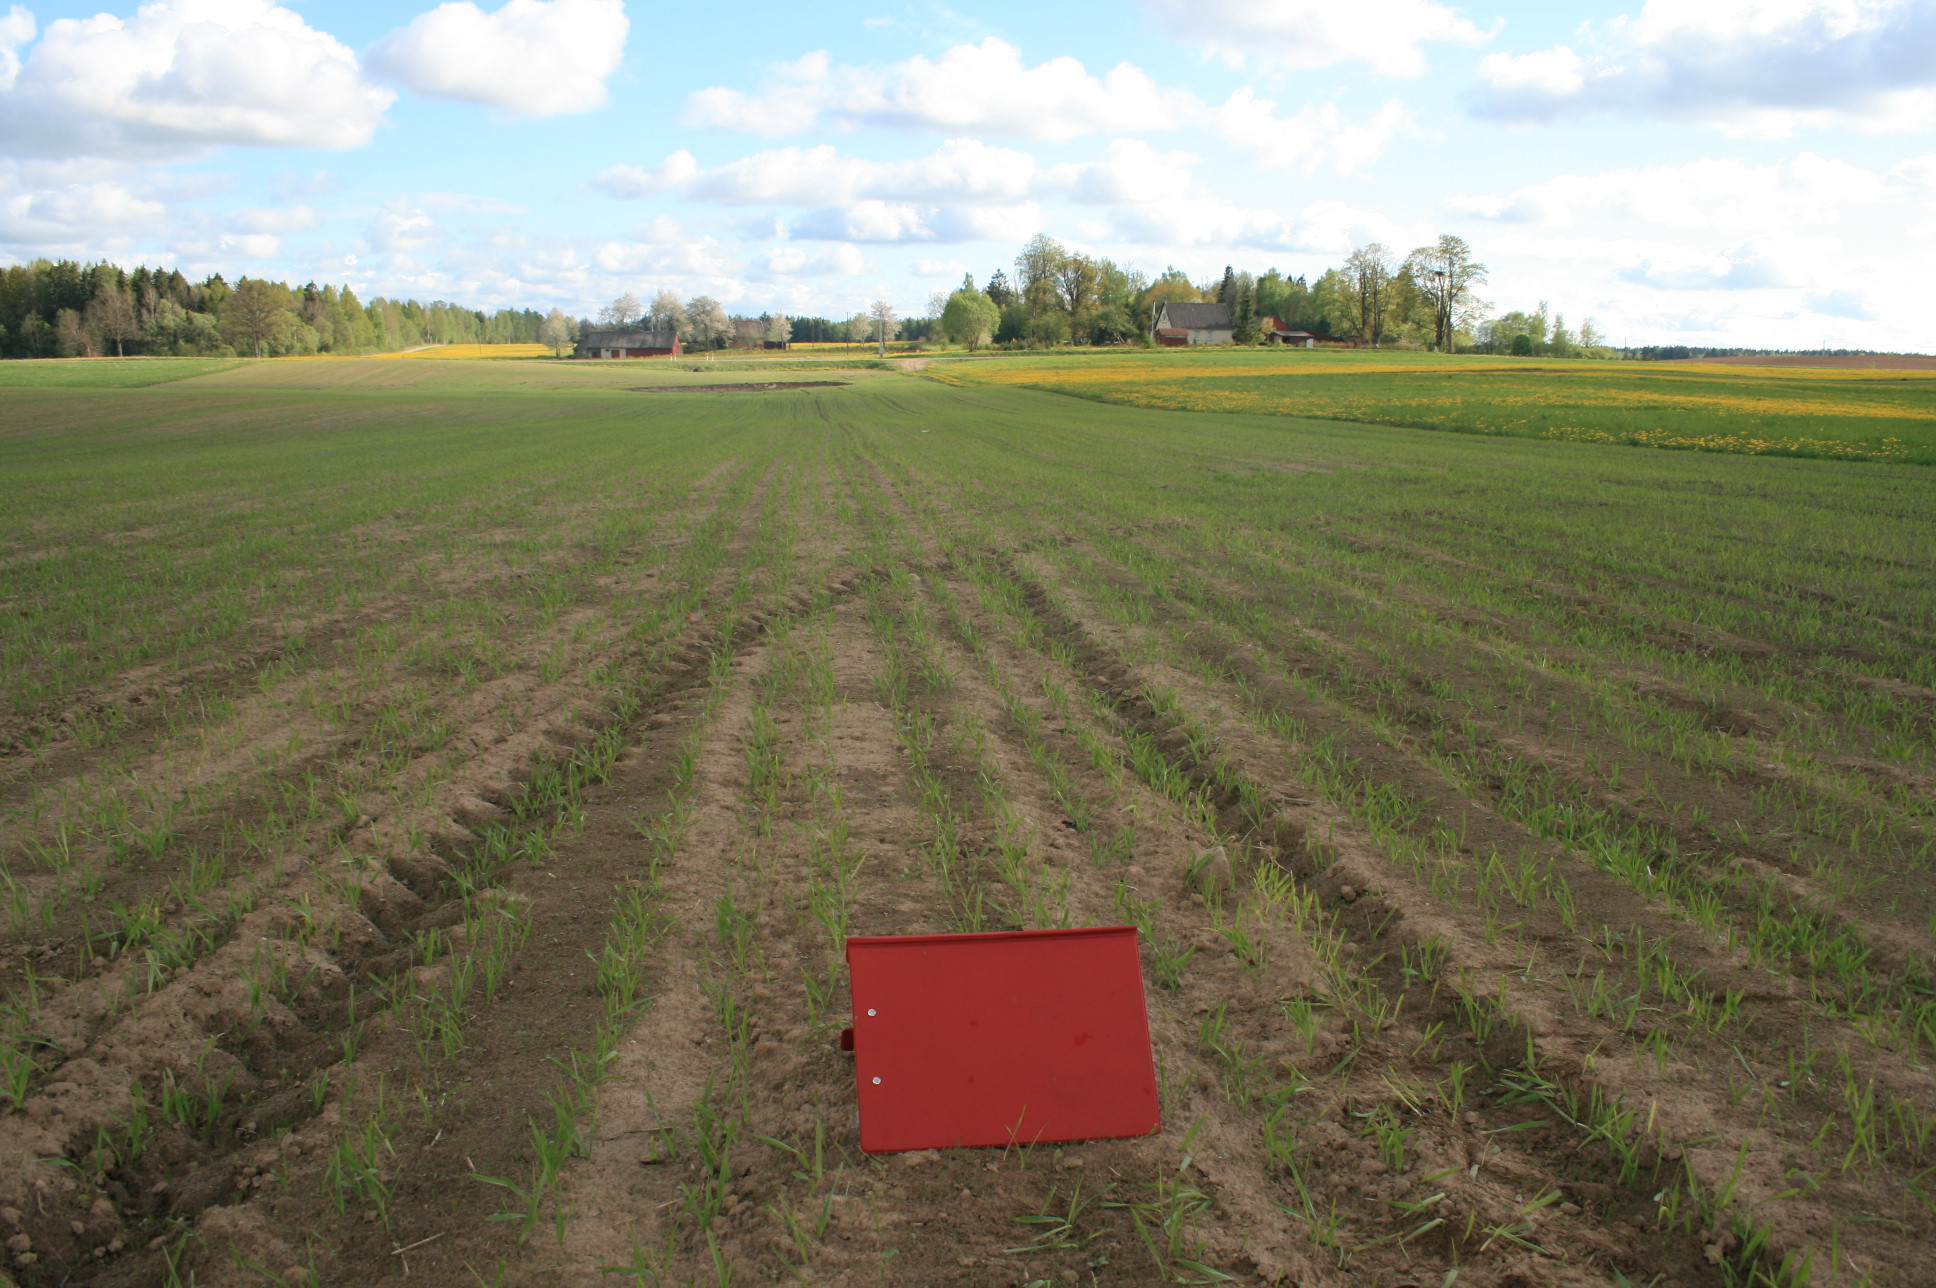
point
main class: Cropland
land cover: Barley
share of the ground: 10 - 25 %
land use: Agriculture (excluding fallow land and kitchen gardens)
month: May
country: LT
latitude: 56.1667
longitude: 22.0164
